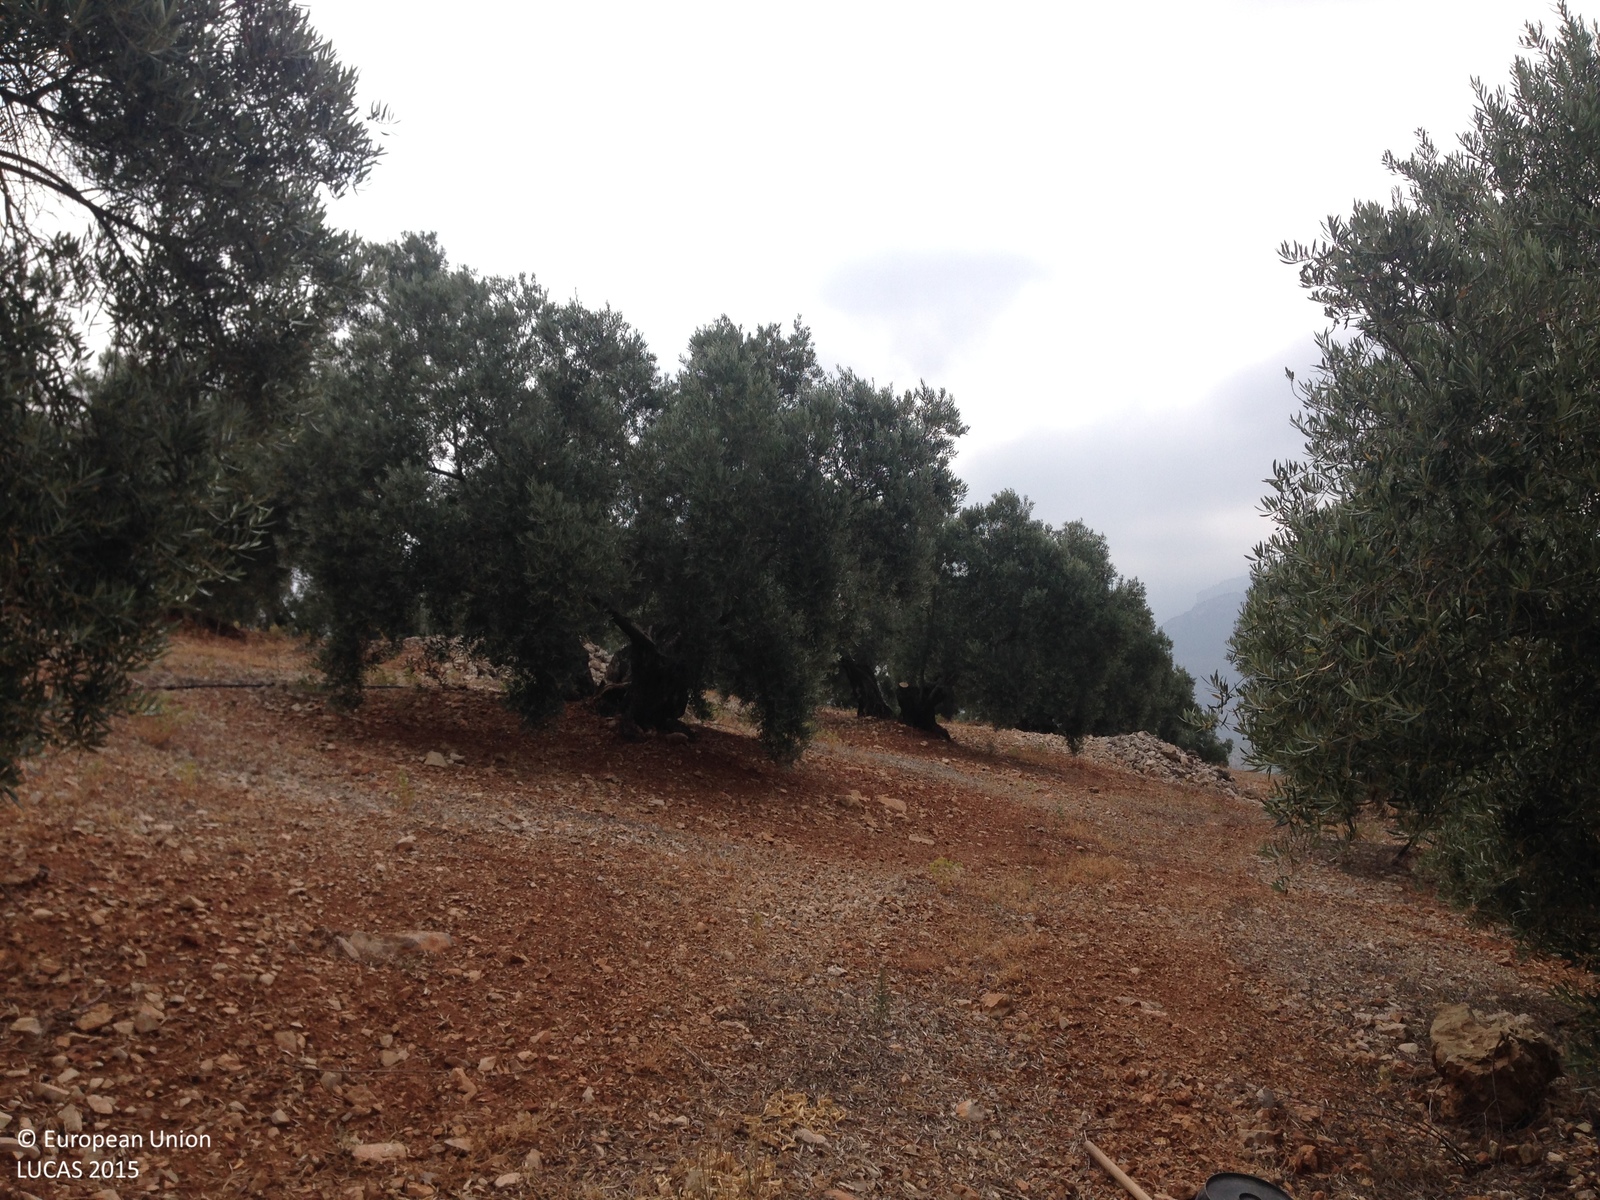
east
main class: Cropland
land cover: Olive groves
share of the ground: 25 - 50 %
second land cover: Other bare soil
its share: > 75 %
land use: Agriculture (excluding fallow land and kitchen gardens)
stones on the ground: > 50 %
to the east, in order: Olive groves; Other bare soil; Other structural elements; Olive groves; Tracks; Olive groves
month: June
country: ES
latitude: 38.1805
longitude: -2.9327
